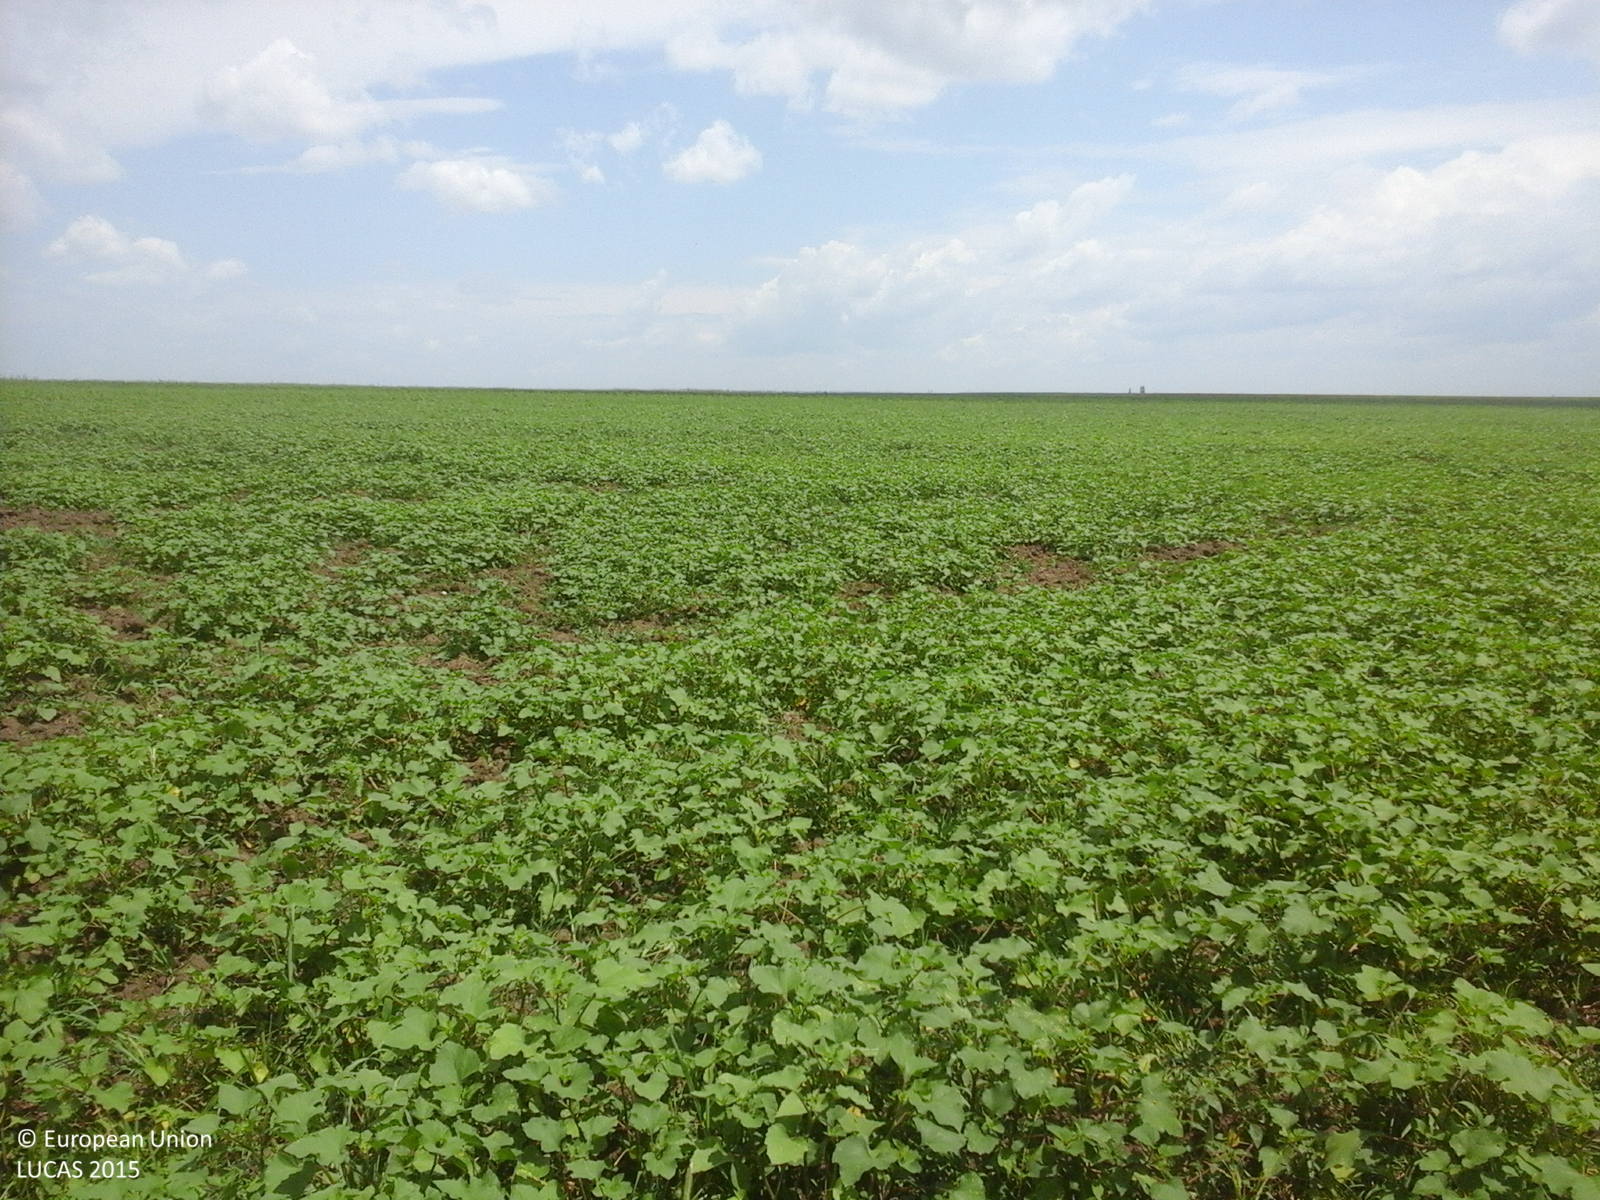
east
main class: Grassland
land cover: Spontaneously vegetated surfaces
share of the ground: > 75 %
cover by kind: herbaceous plants 100 %
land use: Fallow land
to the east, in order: Spontaneously vegetated surfaces
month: July
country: RO
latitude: 43.8789
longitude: 24.2107
